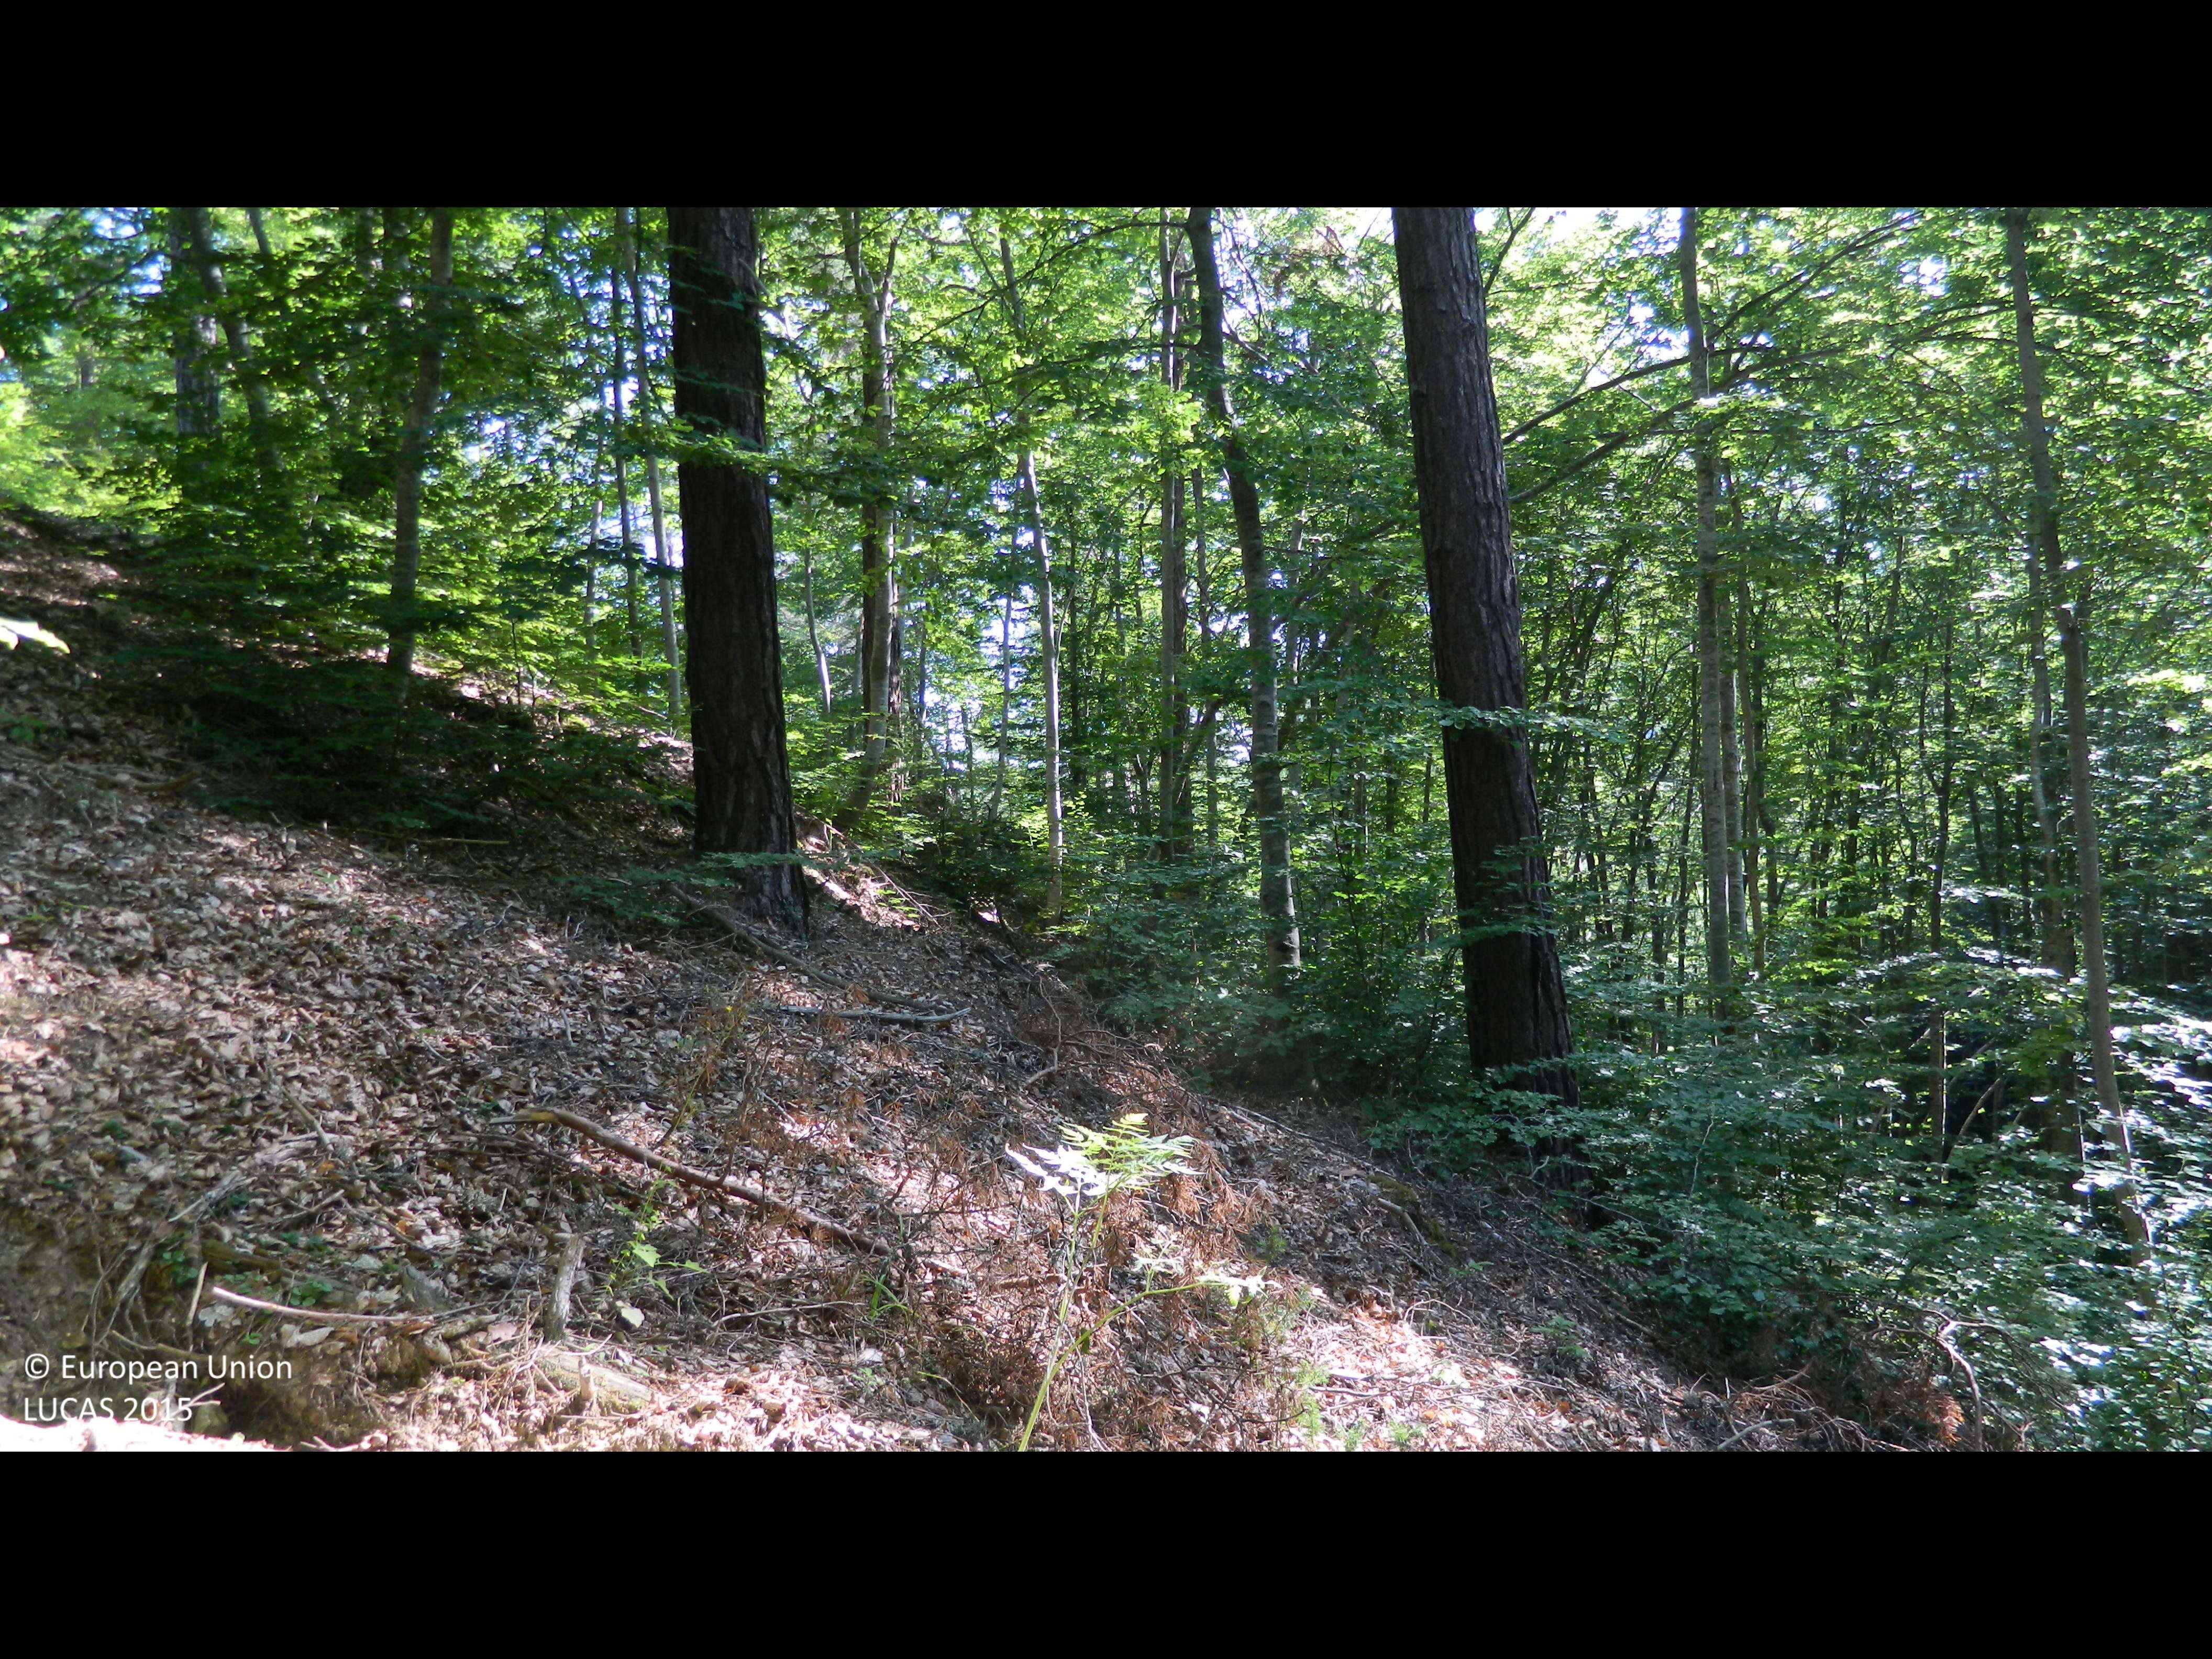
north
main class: Woodland
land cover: Broadleaved woodland
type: mountainous beech forest
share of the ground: > 75 %
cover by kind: broadleaved forest trees 85 %, coniferous forest trees 10 %, unconsolidated bare surface 5 %
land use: Forestry
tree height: > 5 m
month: July
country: BG
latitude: 41.5413
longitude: 24.8012
